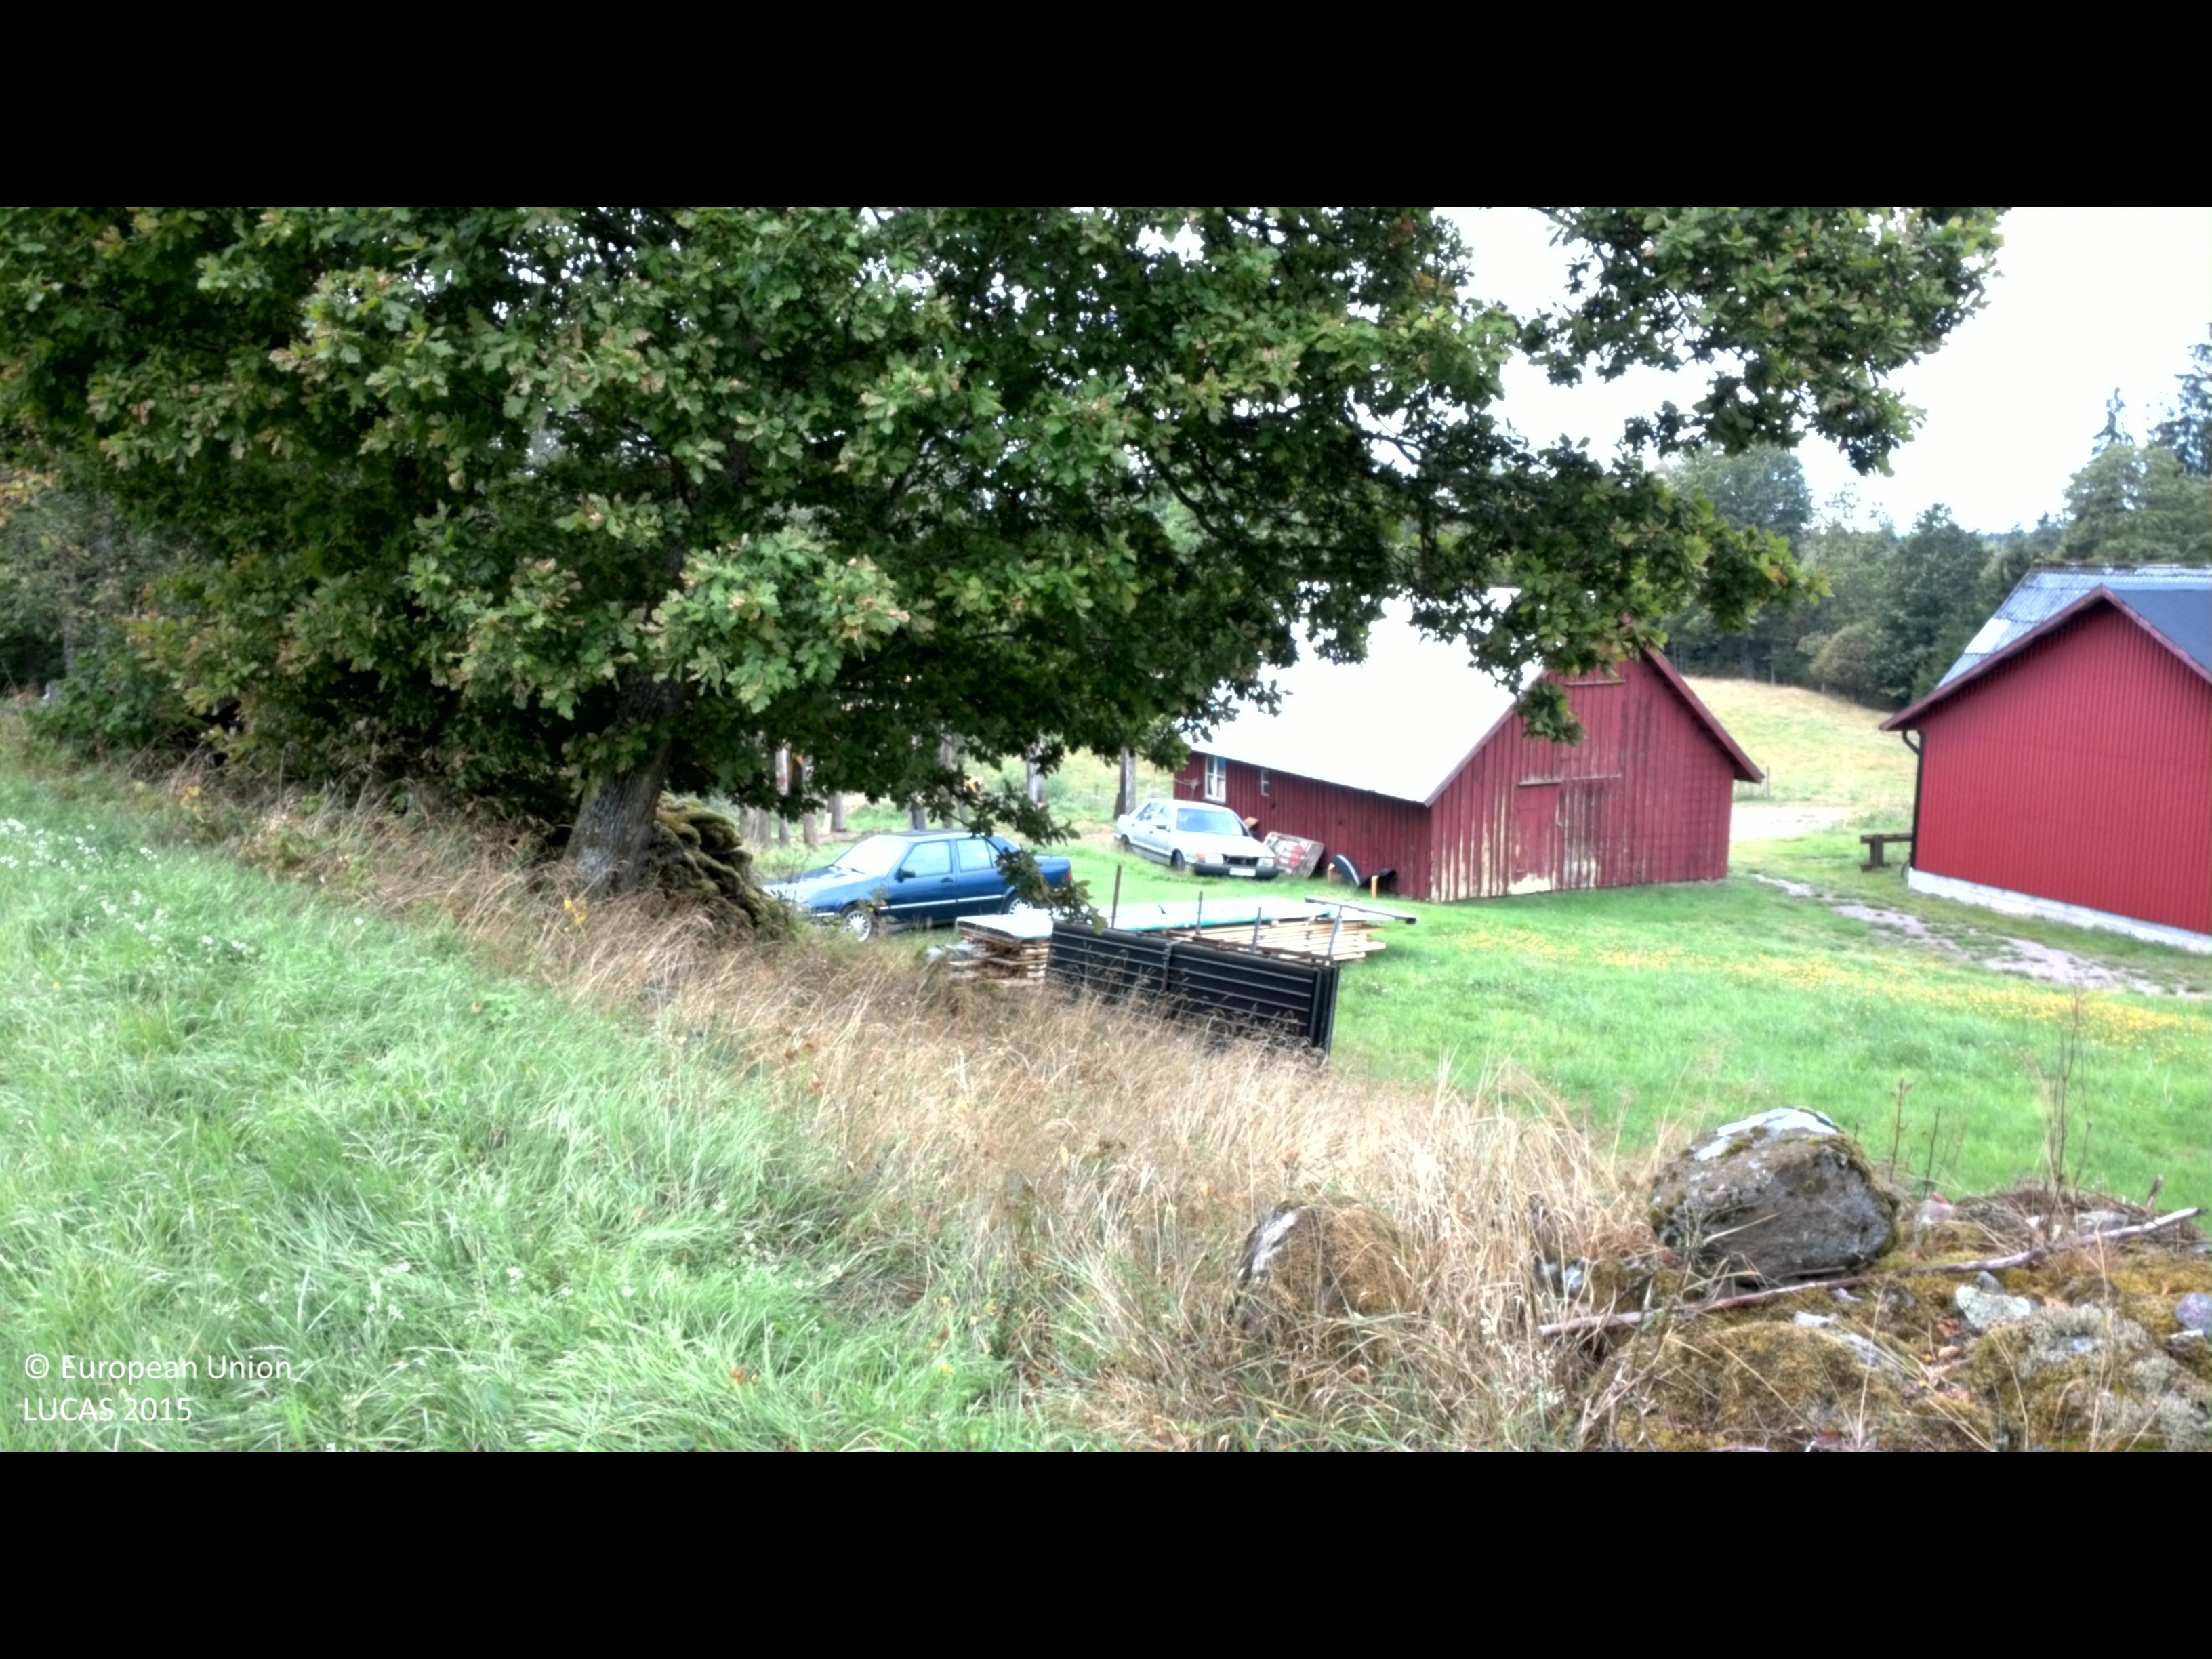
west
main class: Grassland
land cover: Grassland without tree/shrub cover
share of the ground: > 75 %
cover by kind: herbaceous plants 100 %
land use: Agriculture (excluding fallow land and kitchen gardens)
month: August
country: SE
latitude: 56.9934
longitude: 13.2060
